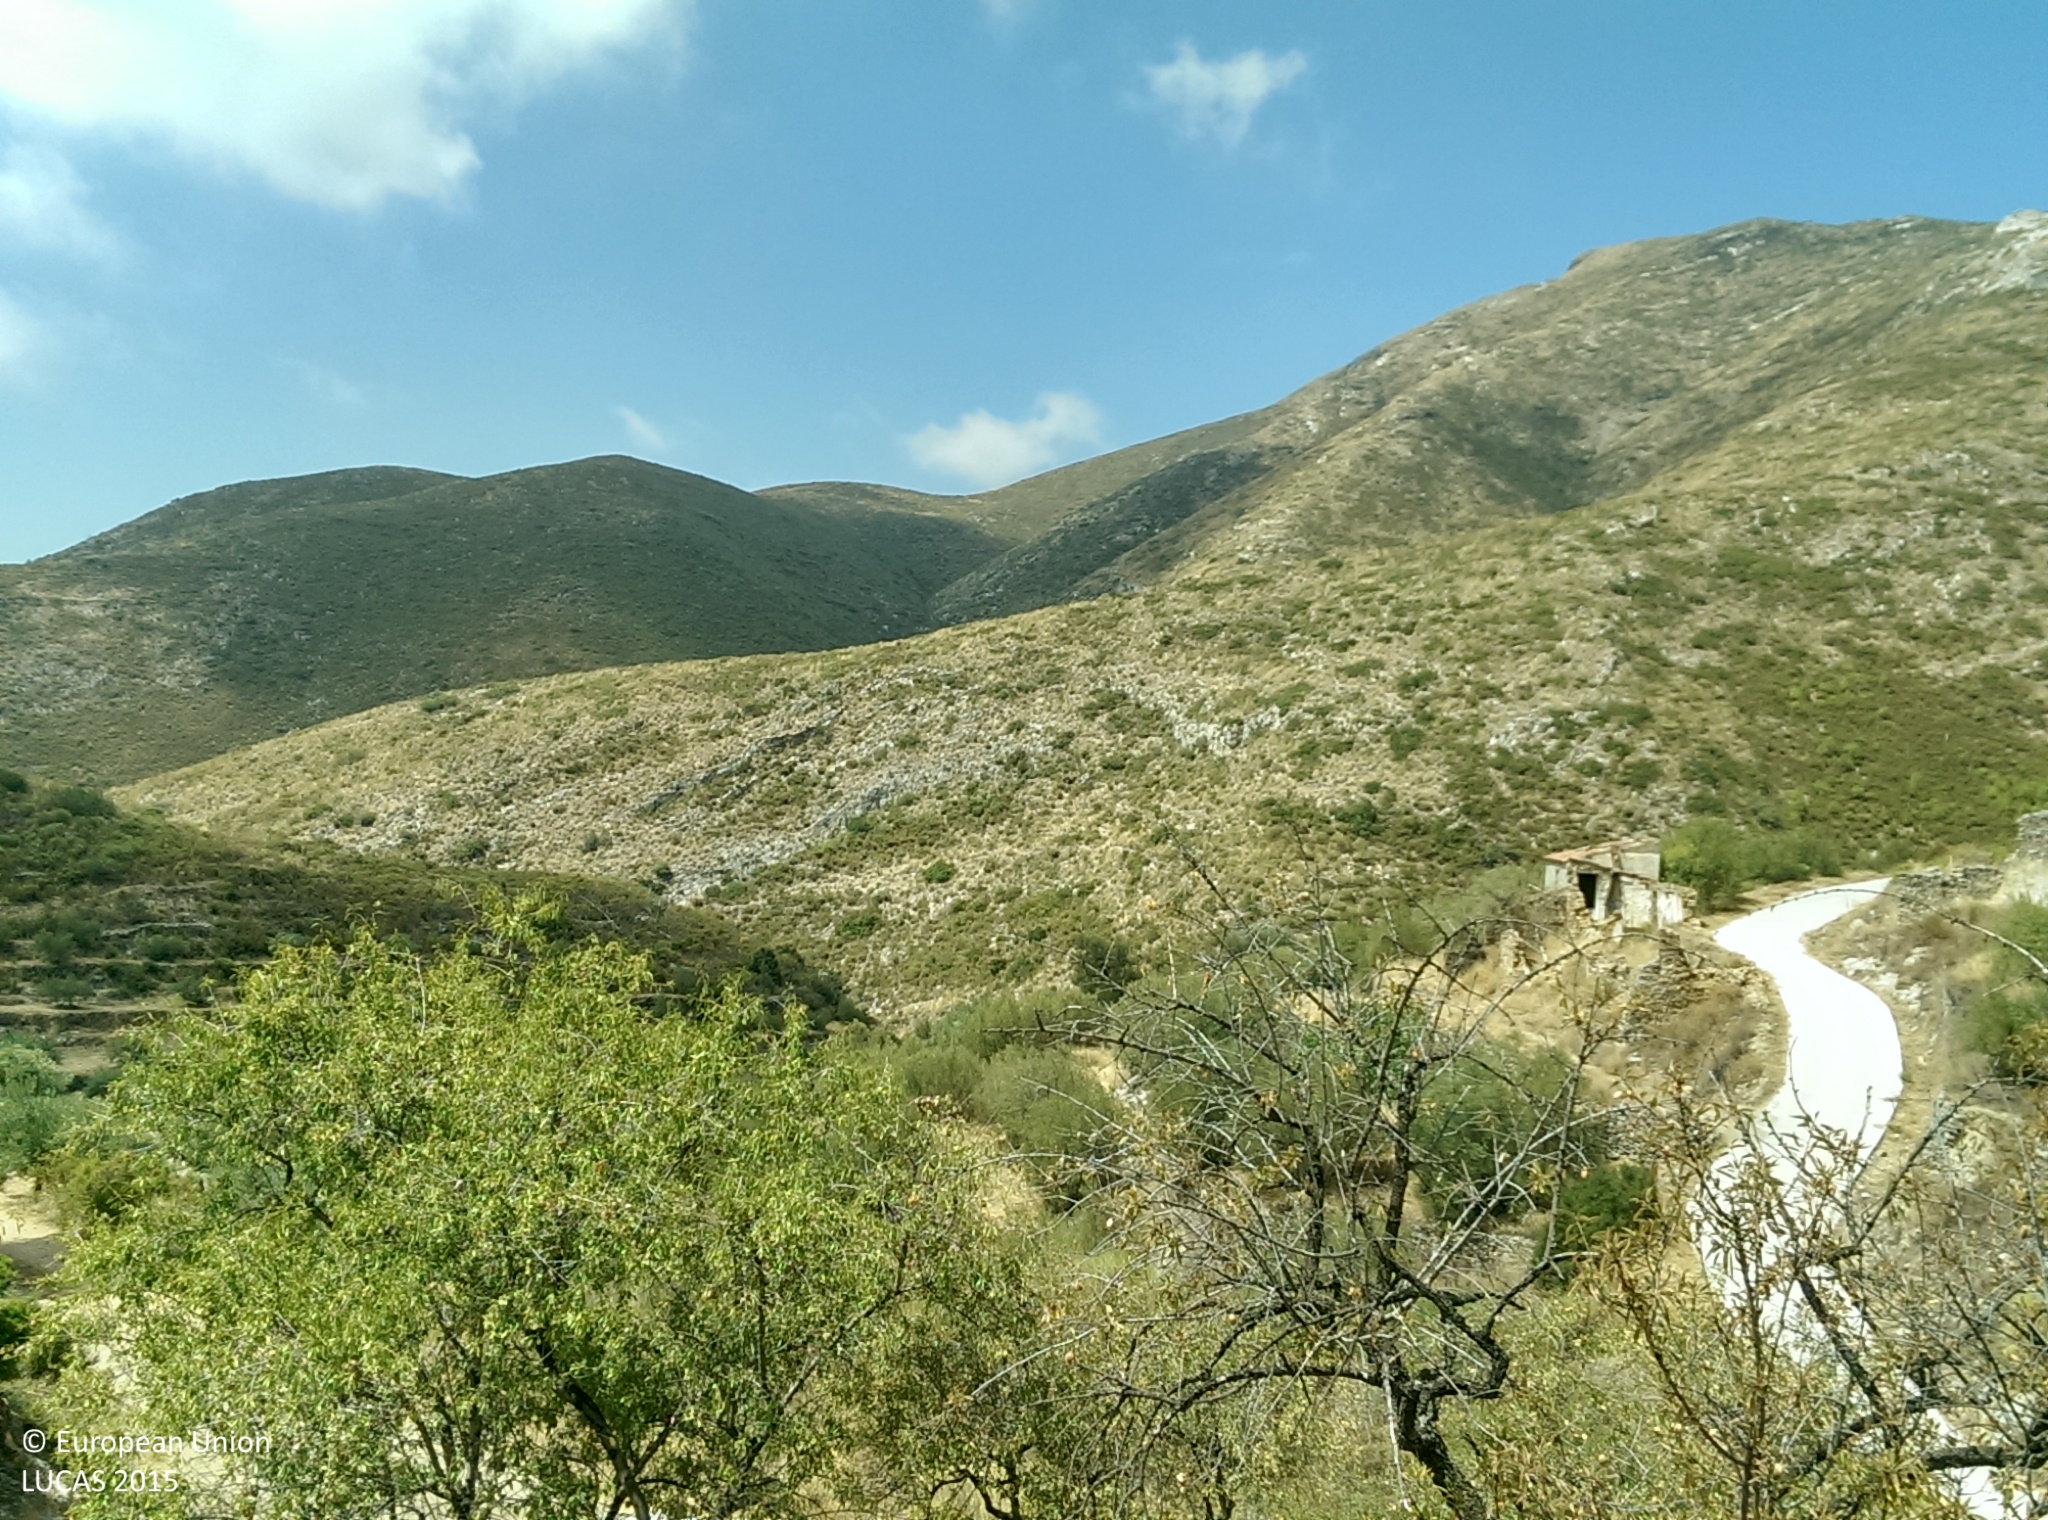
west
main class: Shrubland
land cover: Shrubland without tree cover
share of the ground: > 75 %
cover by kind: shrubs 100 %
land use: Abandoned areas
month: August
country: ES
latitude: 36.8168
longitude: -3.6263
